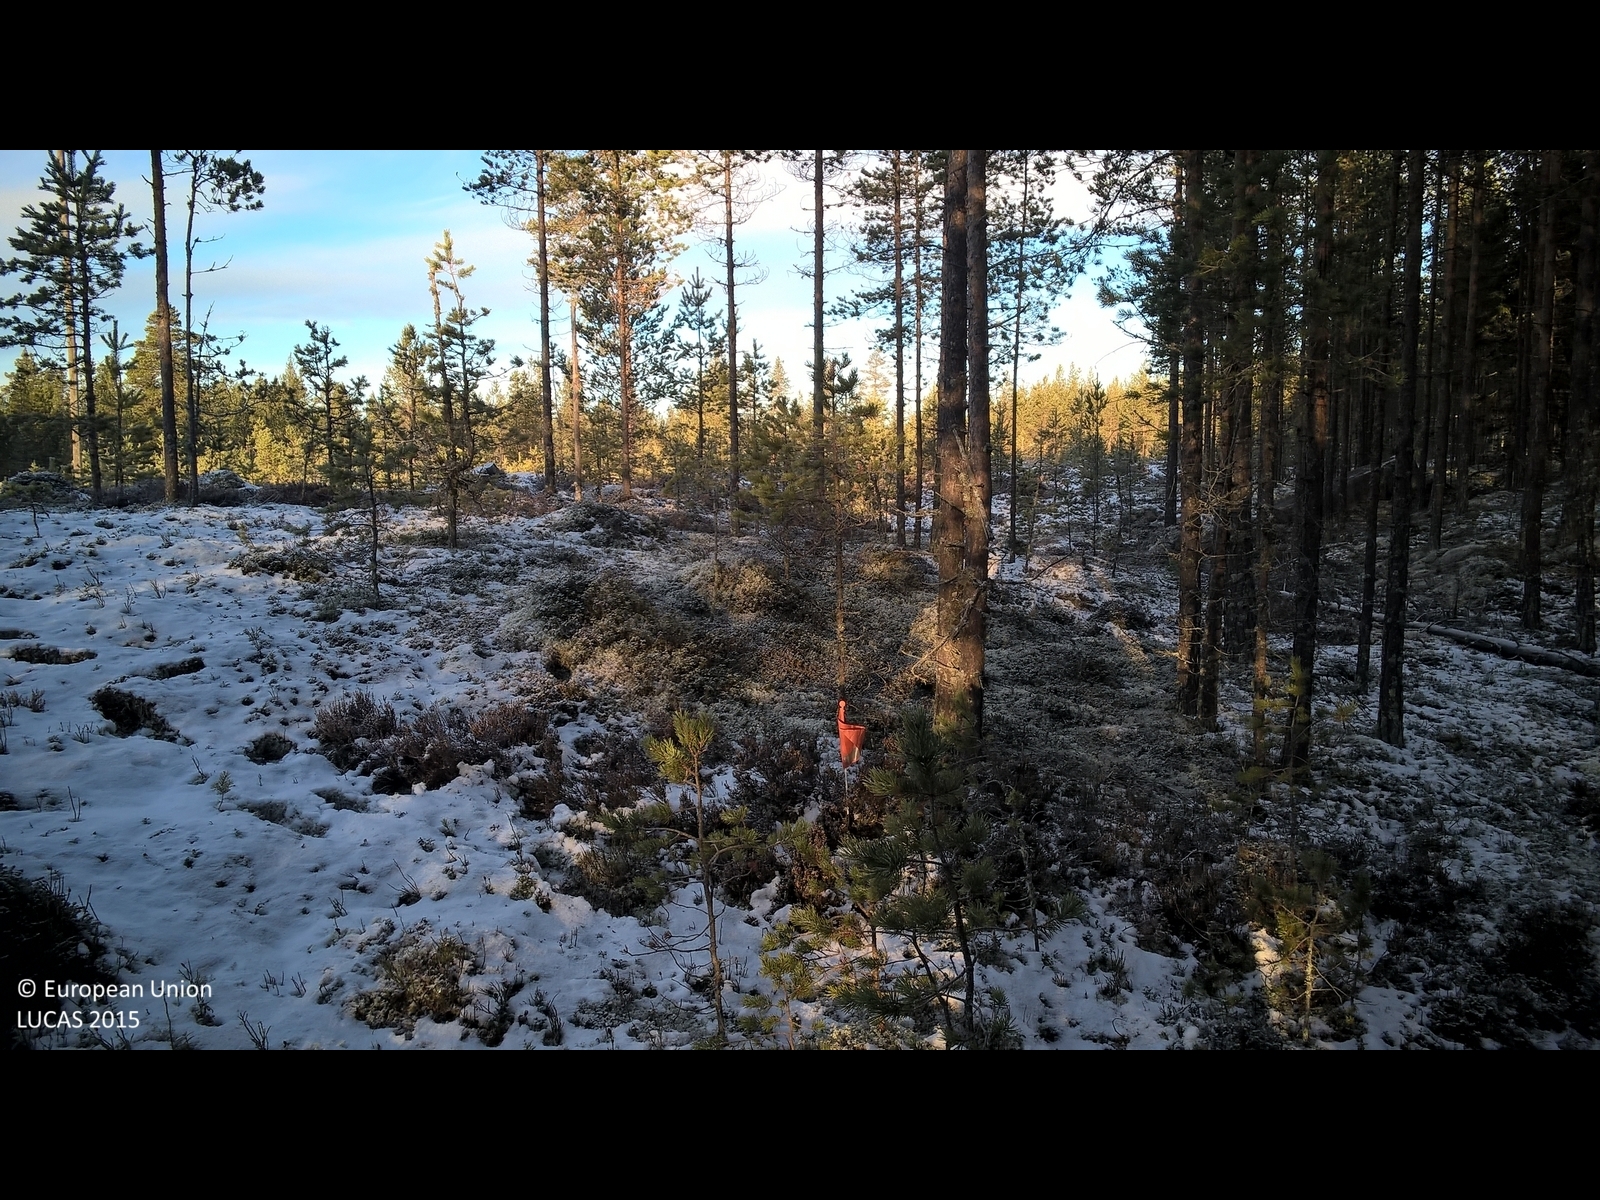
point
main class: Woodland
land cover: Pine dominated coniferous woodland
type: boreal forest
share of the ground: > 75 %
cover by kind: coniferous forest trees 75 %, lichens and mosses 25 %
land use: Forestry
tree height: > 5 m
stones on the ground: < 10 %
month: November
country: SE
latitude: 60.7295
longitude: 13.6010
